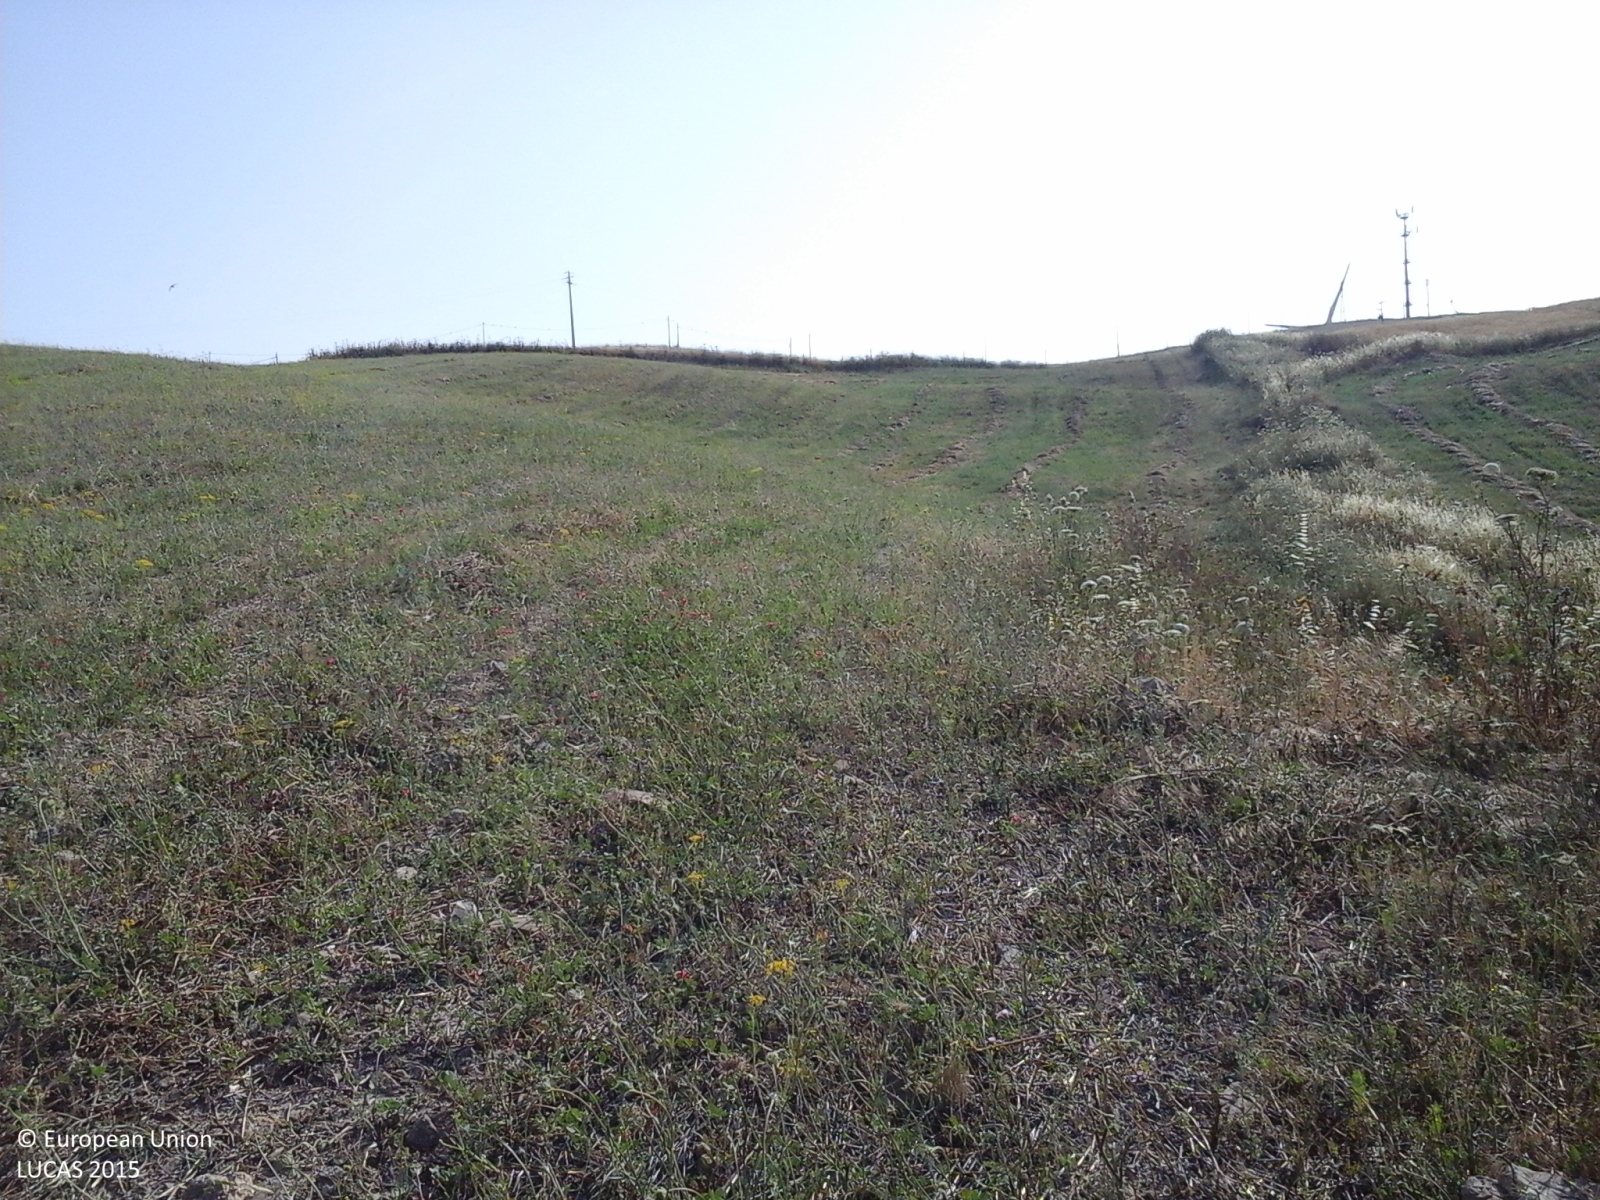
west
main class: Cropland
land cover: Temporary grasslands
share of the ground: > 75 %
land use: Agriculture (excluding fallow land and kitchen gardens)
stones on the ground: < 10 %
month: June
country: IT
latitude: 37.7704
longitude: 13.5953
